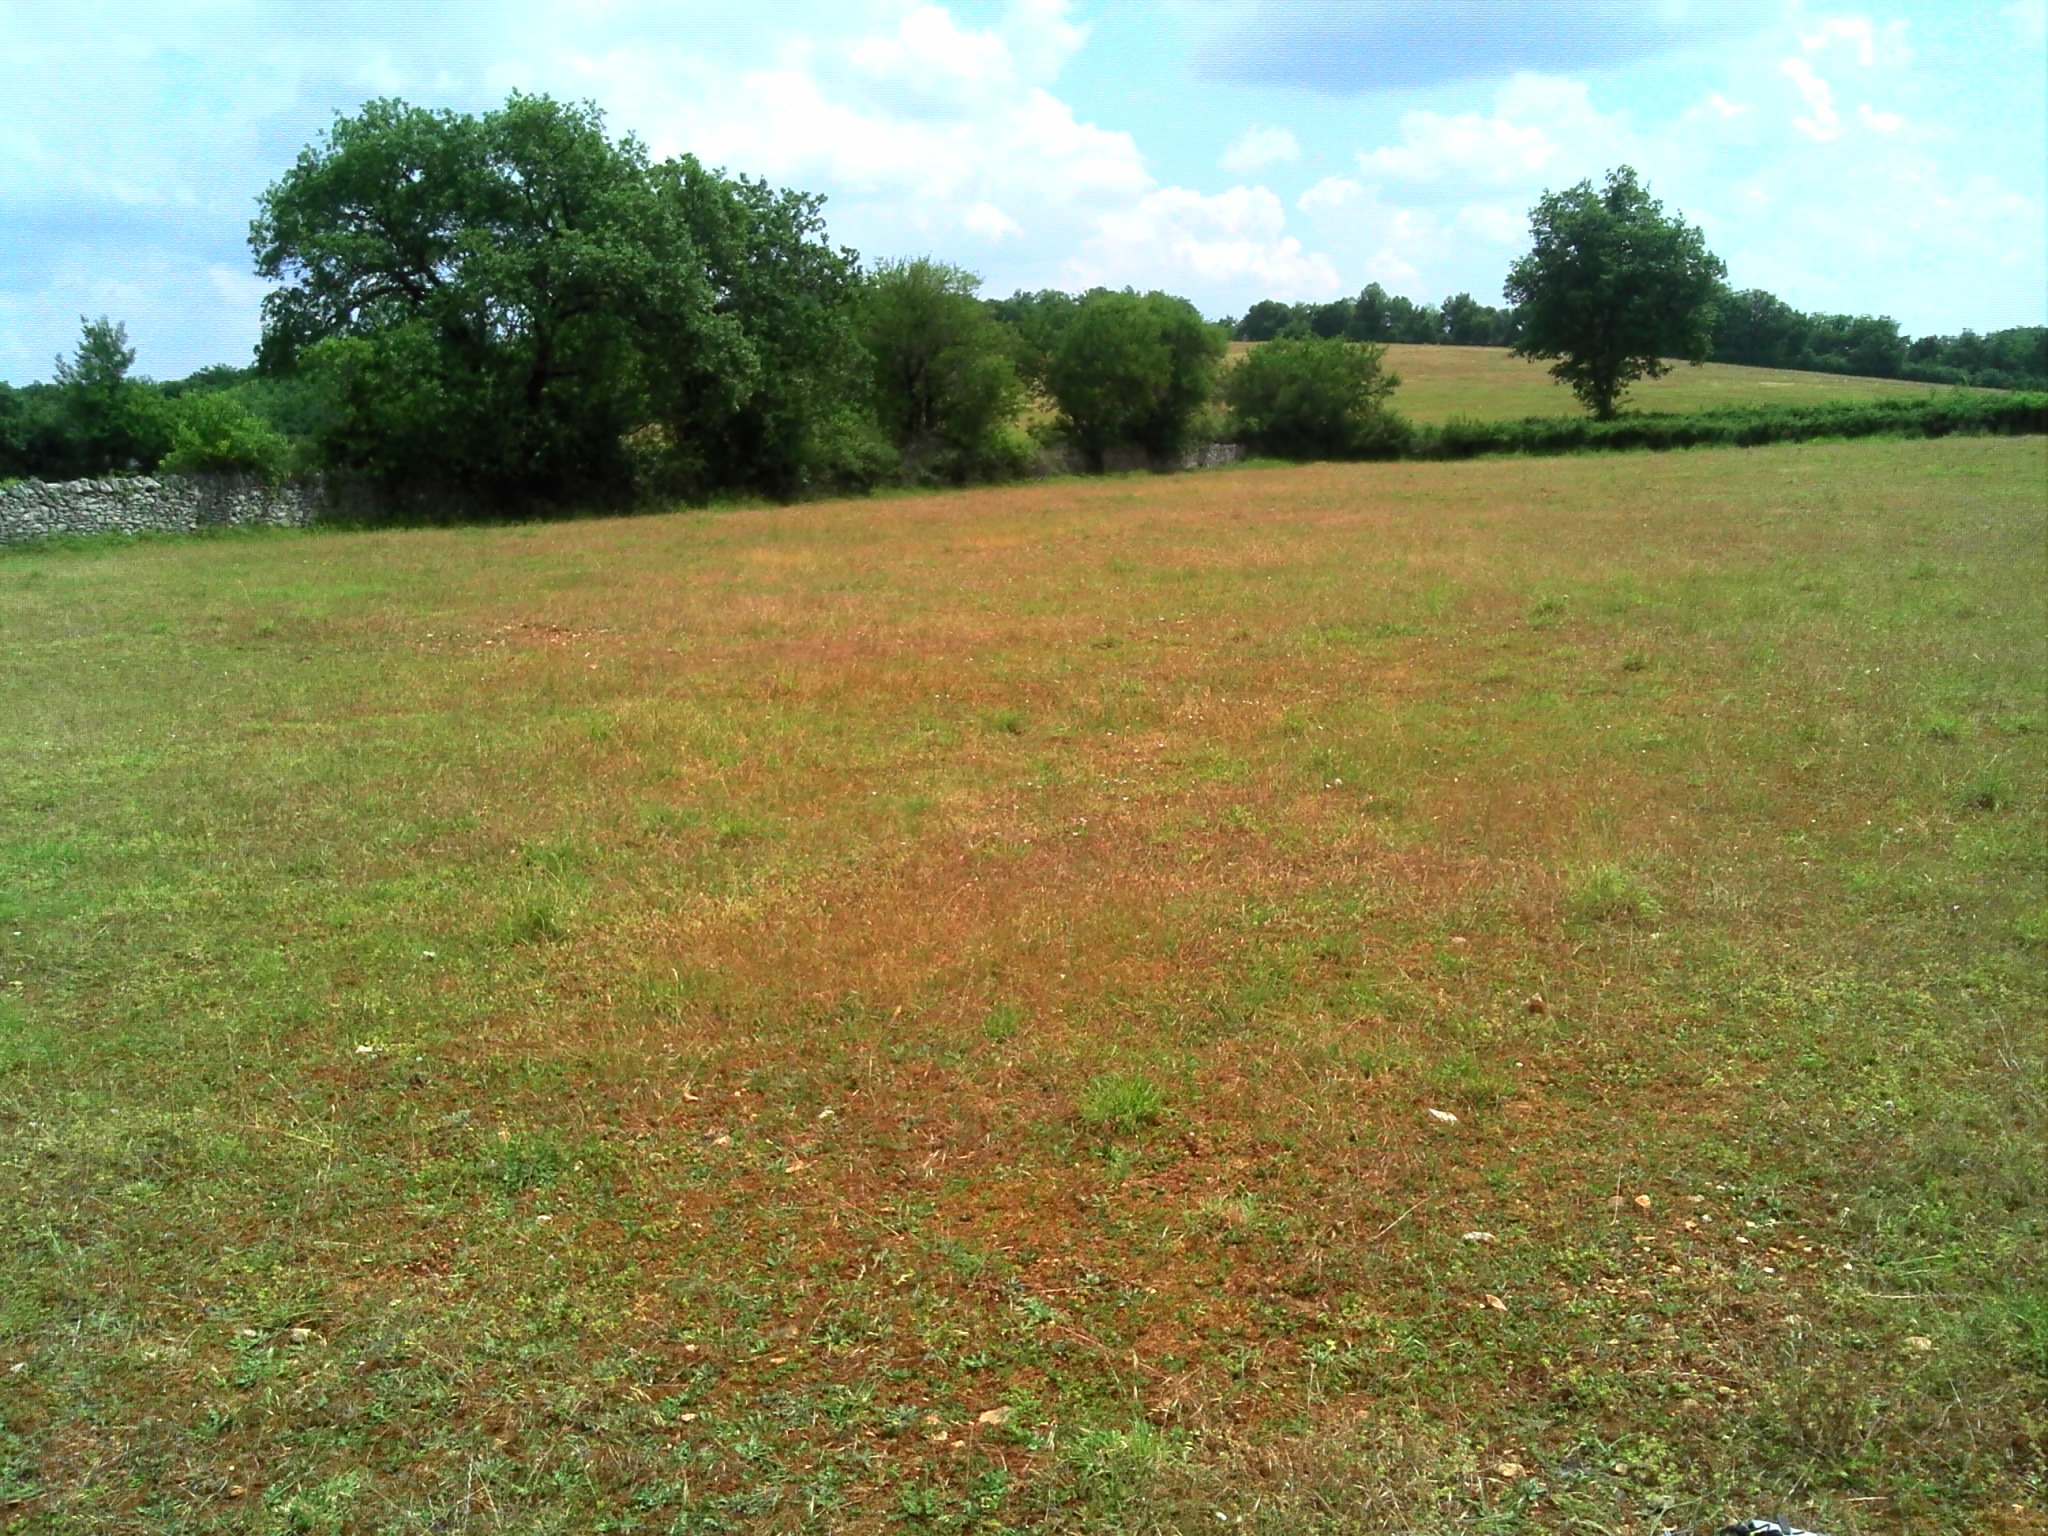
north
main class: Grassland
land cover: Spontaneously vegetated surfaces
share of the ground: > 75 %
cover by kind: herbaceous plants 95 %, shrubs 5 %
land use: Agriculture (excluding fallow land and kitchen gardens)
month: June
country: FR
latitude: 44.6052
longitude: 1.7968
